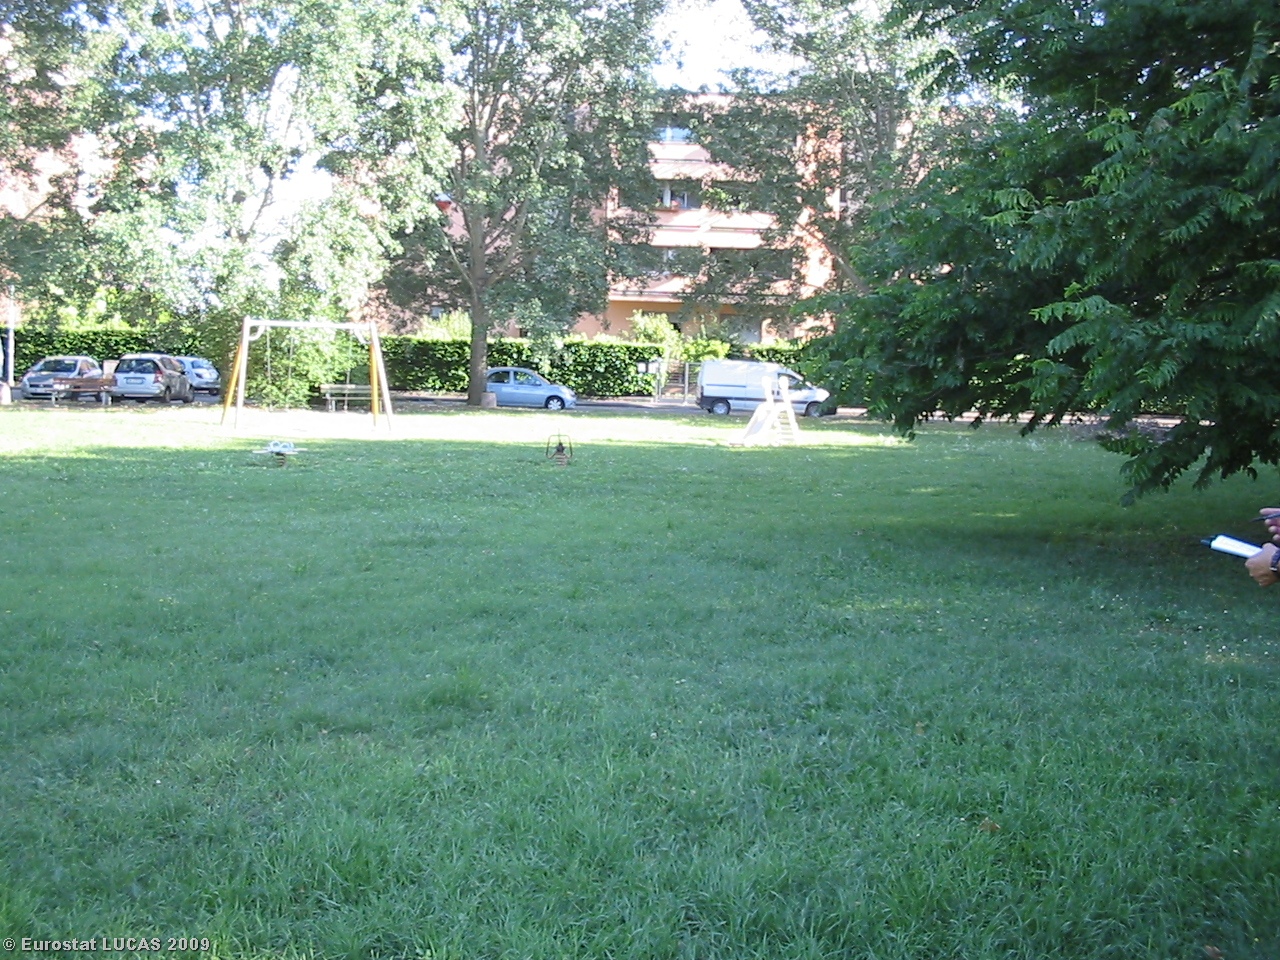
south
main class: Artificial land
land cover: Buildings with 1 to 3 floors
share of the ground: > 75 %
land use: Residential
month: June
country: IT
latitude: 44.7828
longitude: 10.3405
